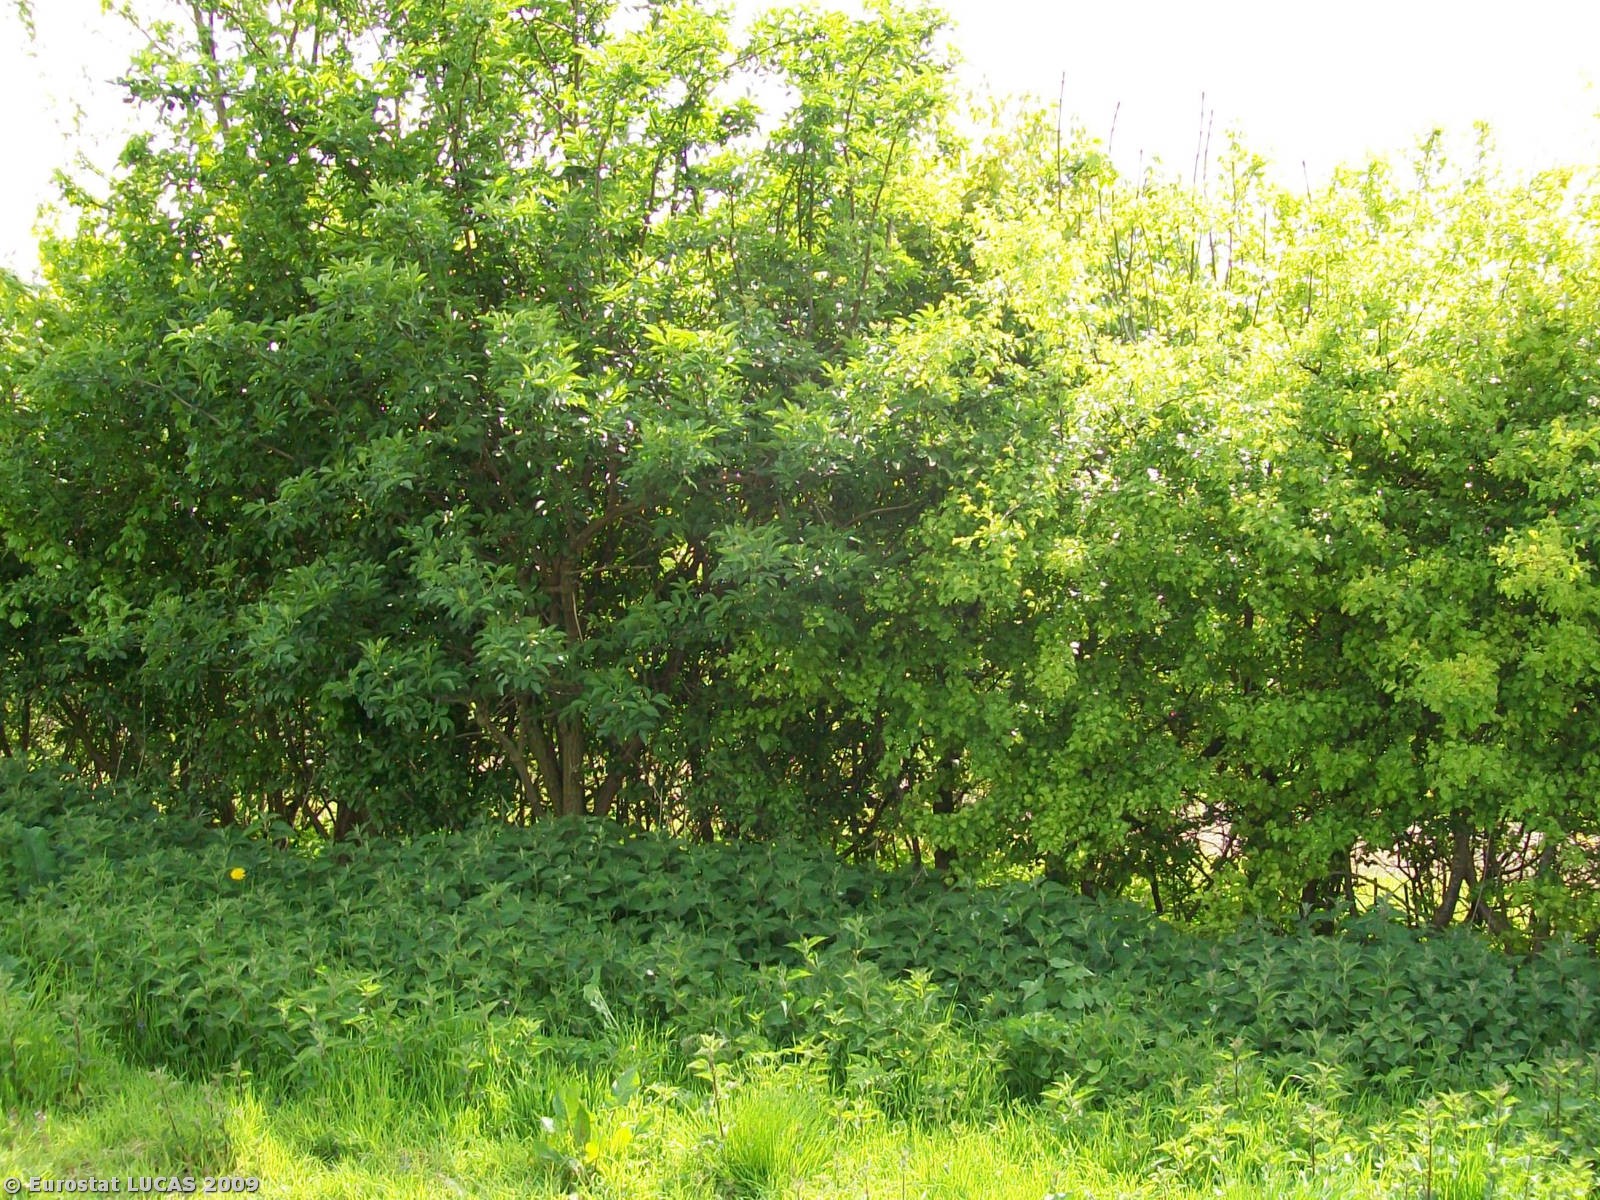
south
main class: Cropland
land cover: Common wheat
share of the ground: 50 - 75 %
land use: Agriculture (excluding fallow land and kitchen gardens)
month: April
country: GB
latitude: 51.6019
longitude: -1.0906
